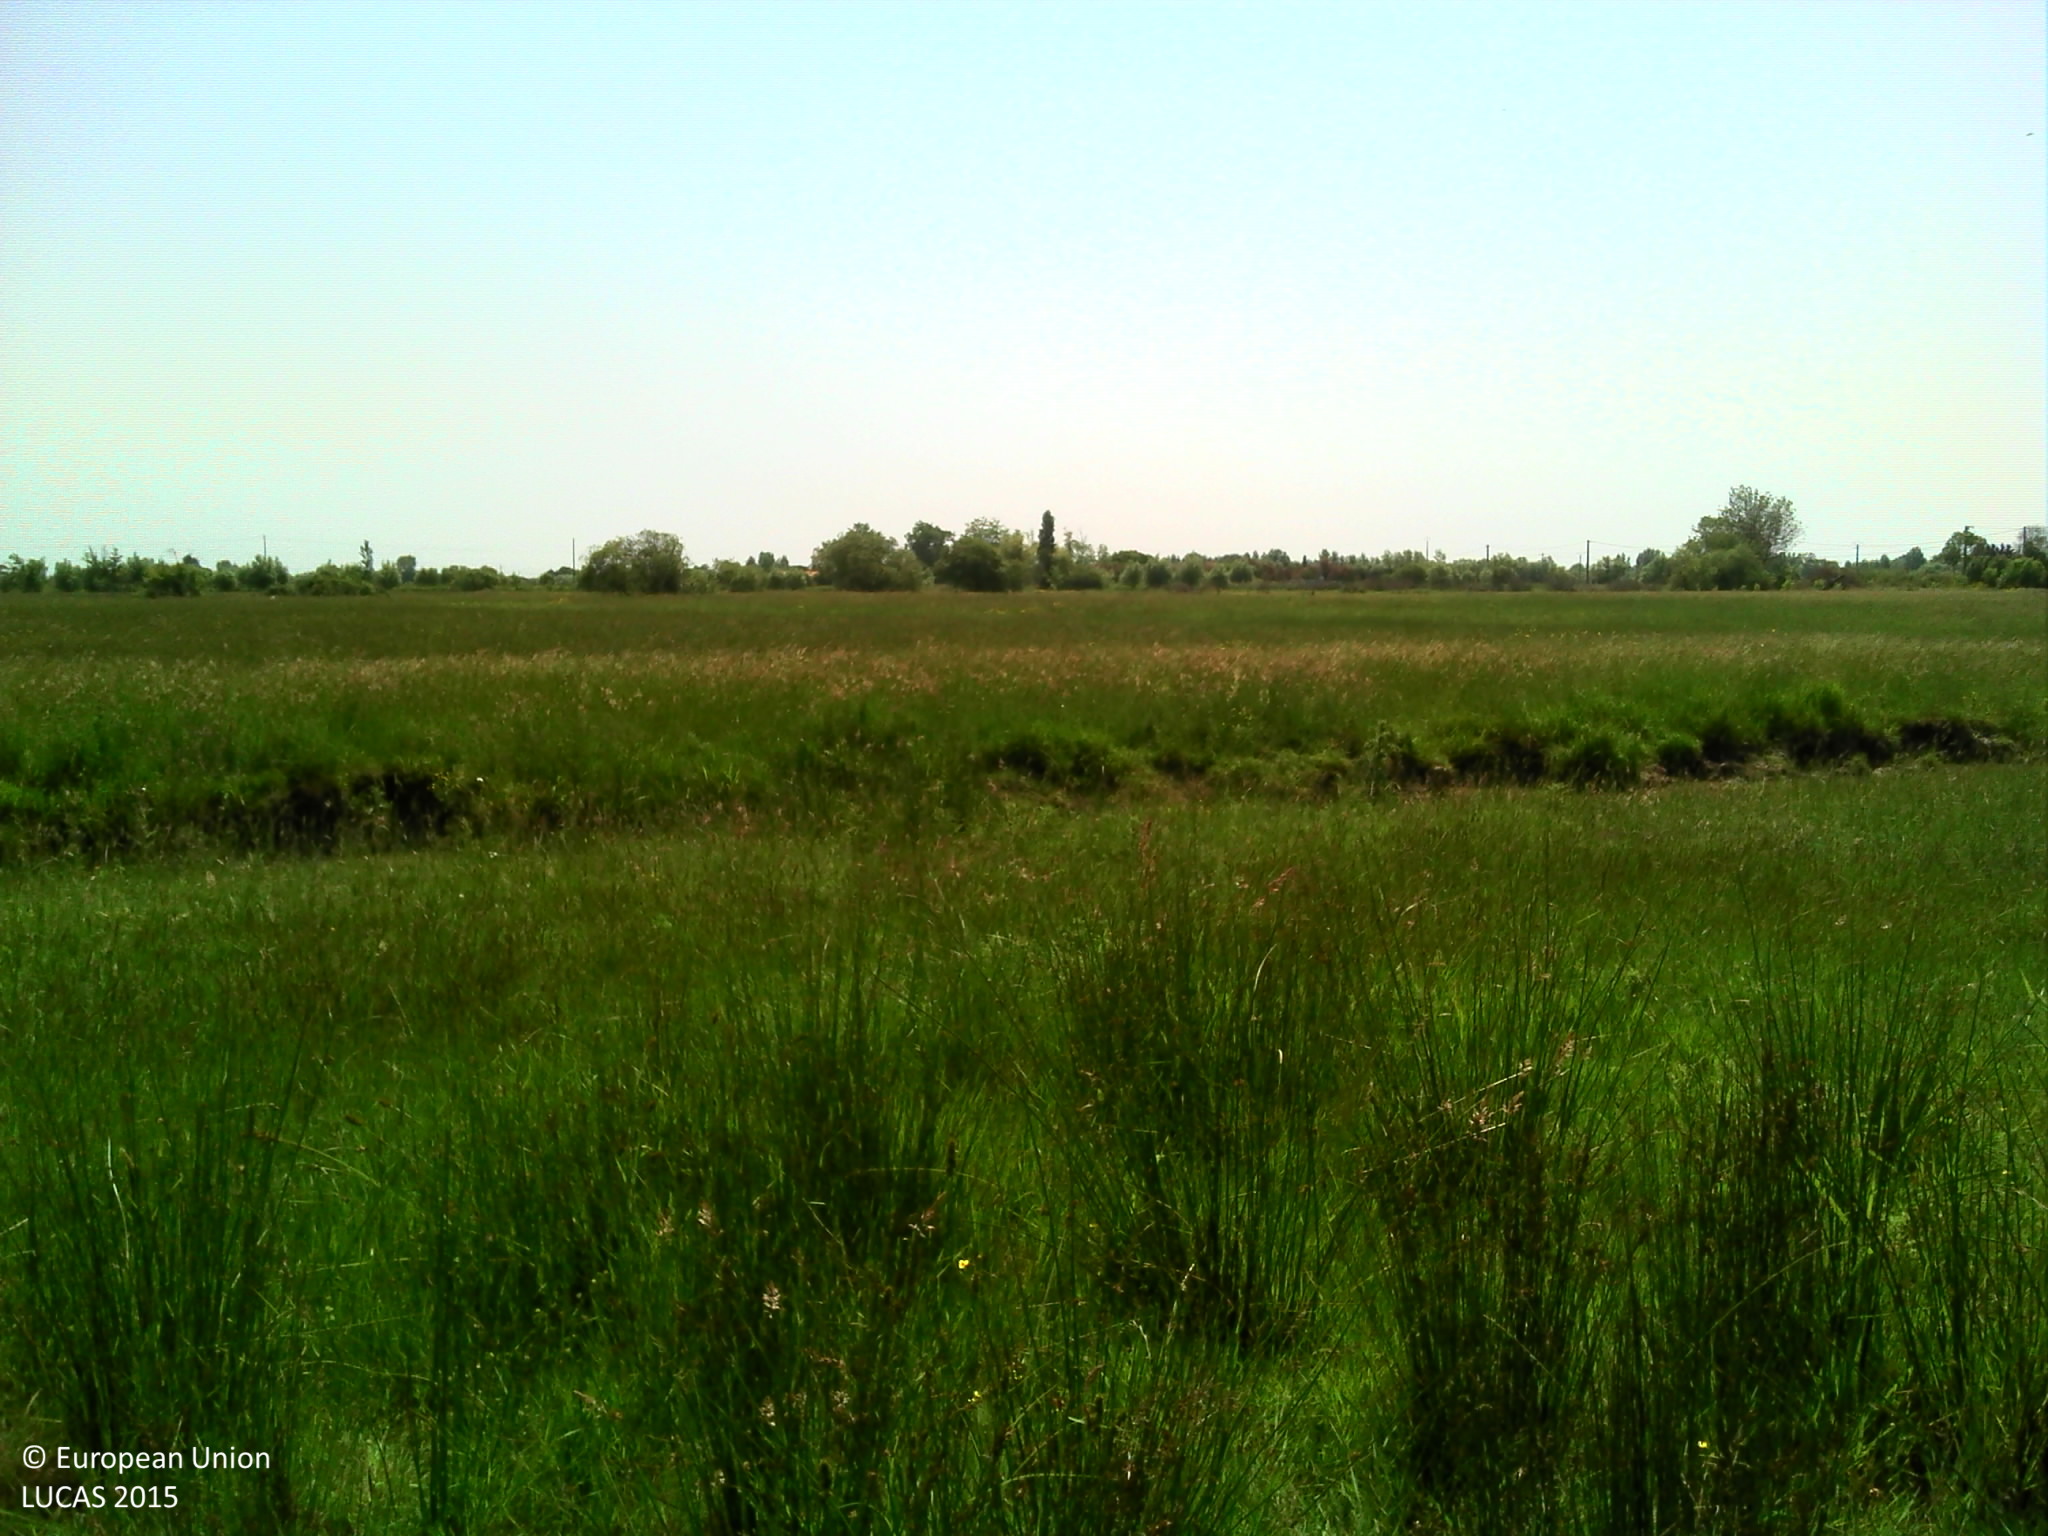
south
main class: Grassland
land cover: Grassland without tree/shrub cover
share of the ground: > 75 %
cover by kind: herbaceous plants 100 %
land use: Agriculture (excluding fallow land and kitchen gardens)
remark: Temporary flooded
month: June
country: FR
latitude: 46.8060
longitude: -1.9568
